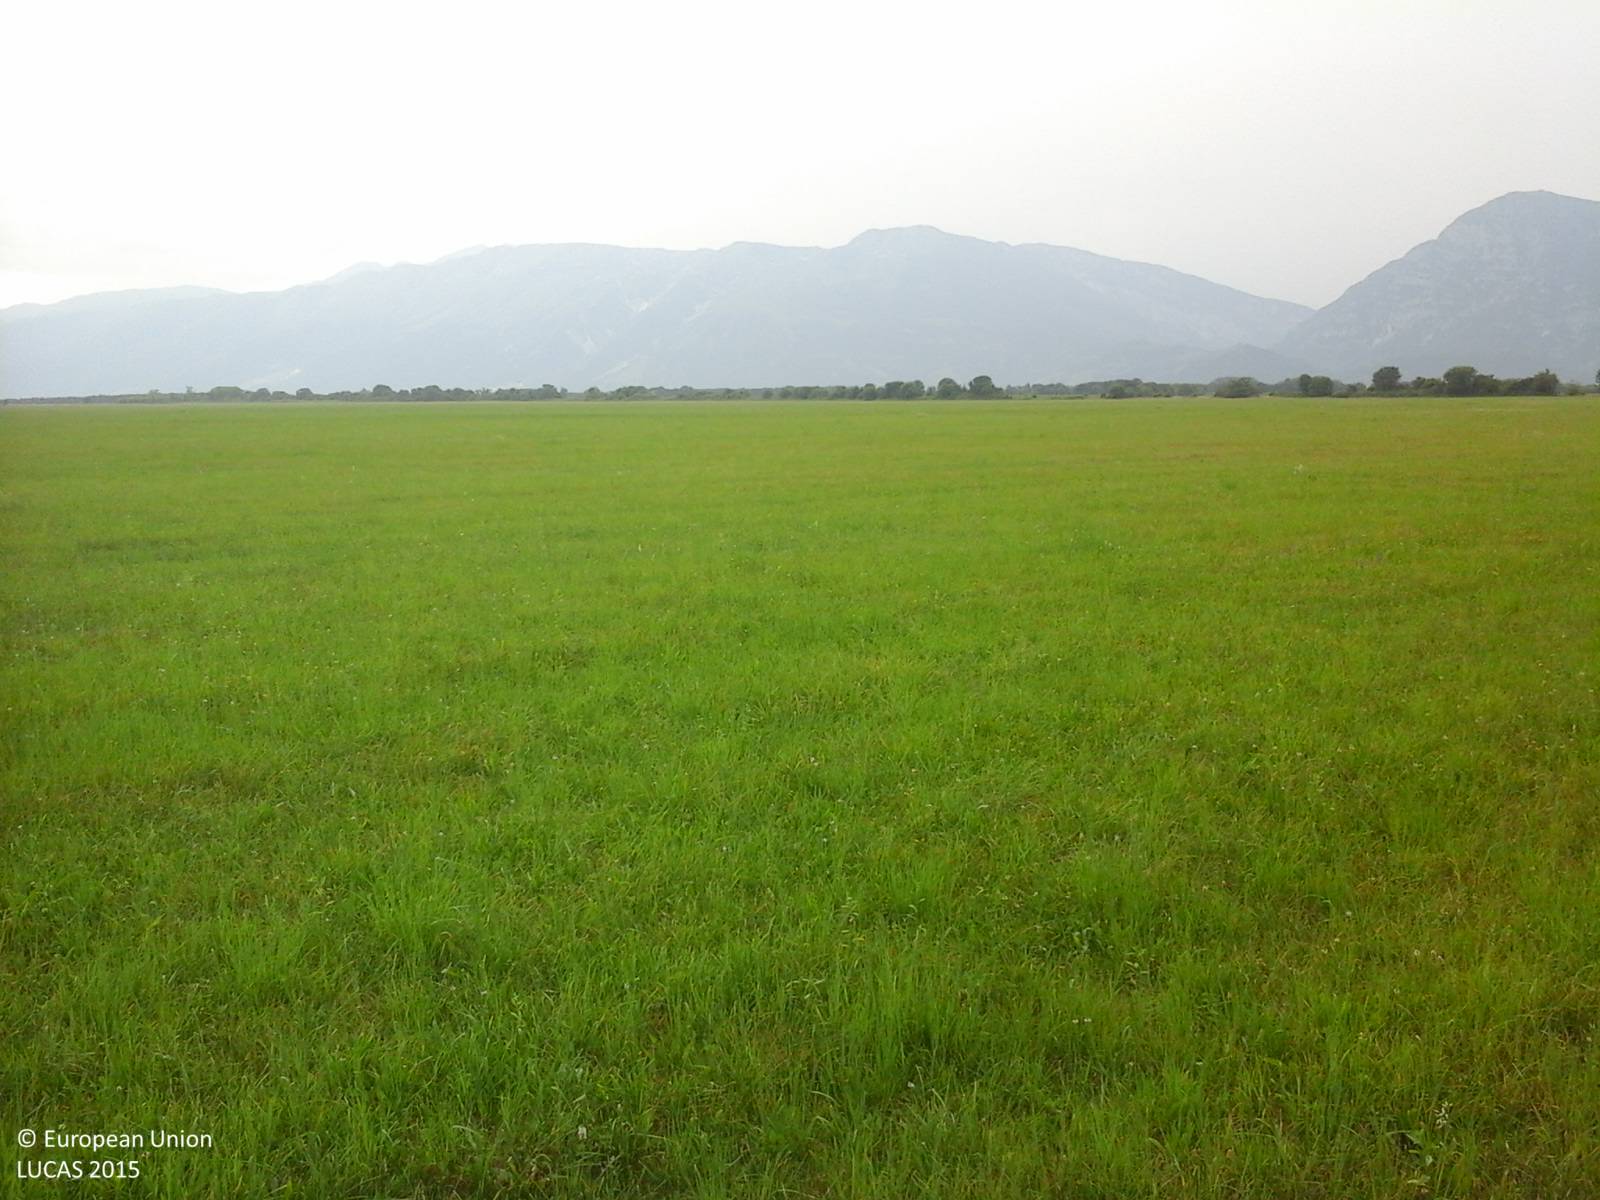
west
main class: Grassland
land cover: Grassland without tree/shrub cover
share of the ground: > 75 %
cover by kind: herbaceous plants 100 %
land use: Agriculture (excluding fallow land and kitchen gardens)
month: June
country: IT
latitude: 46.1362
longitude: 12.7280
